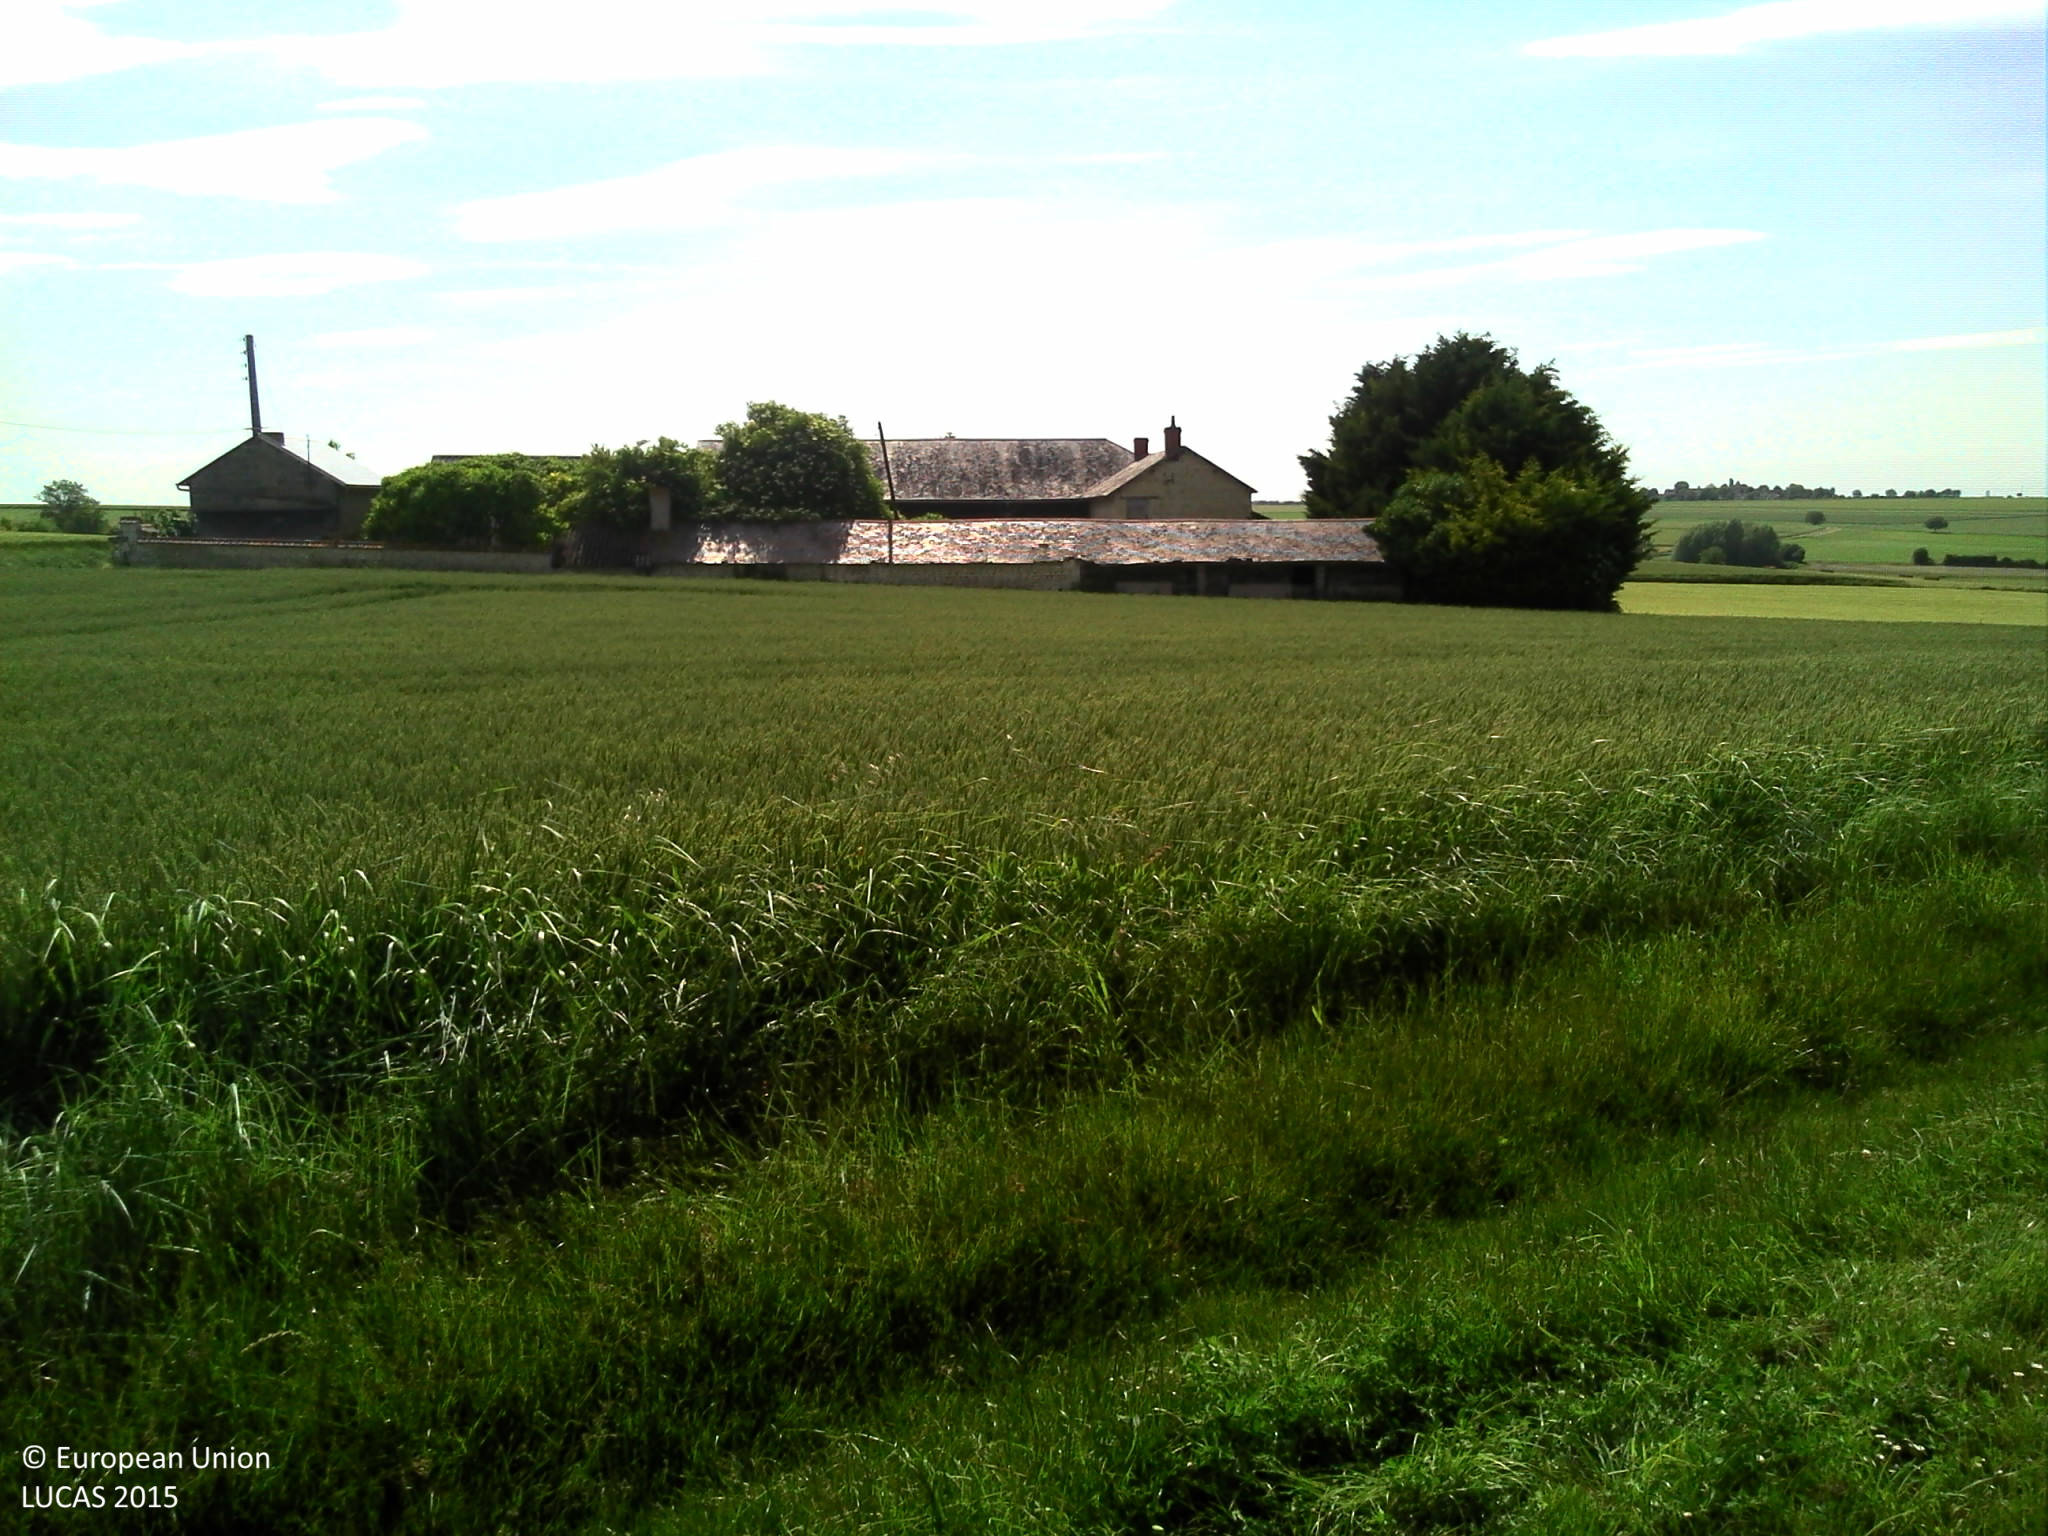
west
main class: Cropland
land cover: Rape and turnip rape
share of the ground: > 75 %
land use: Agriculture (excluding fallow land and kitchen gardens)
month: June
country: FR
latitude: 46.9534
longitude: 0.2154
